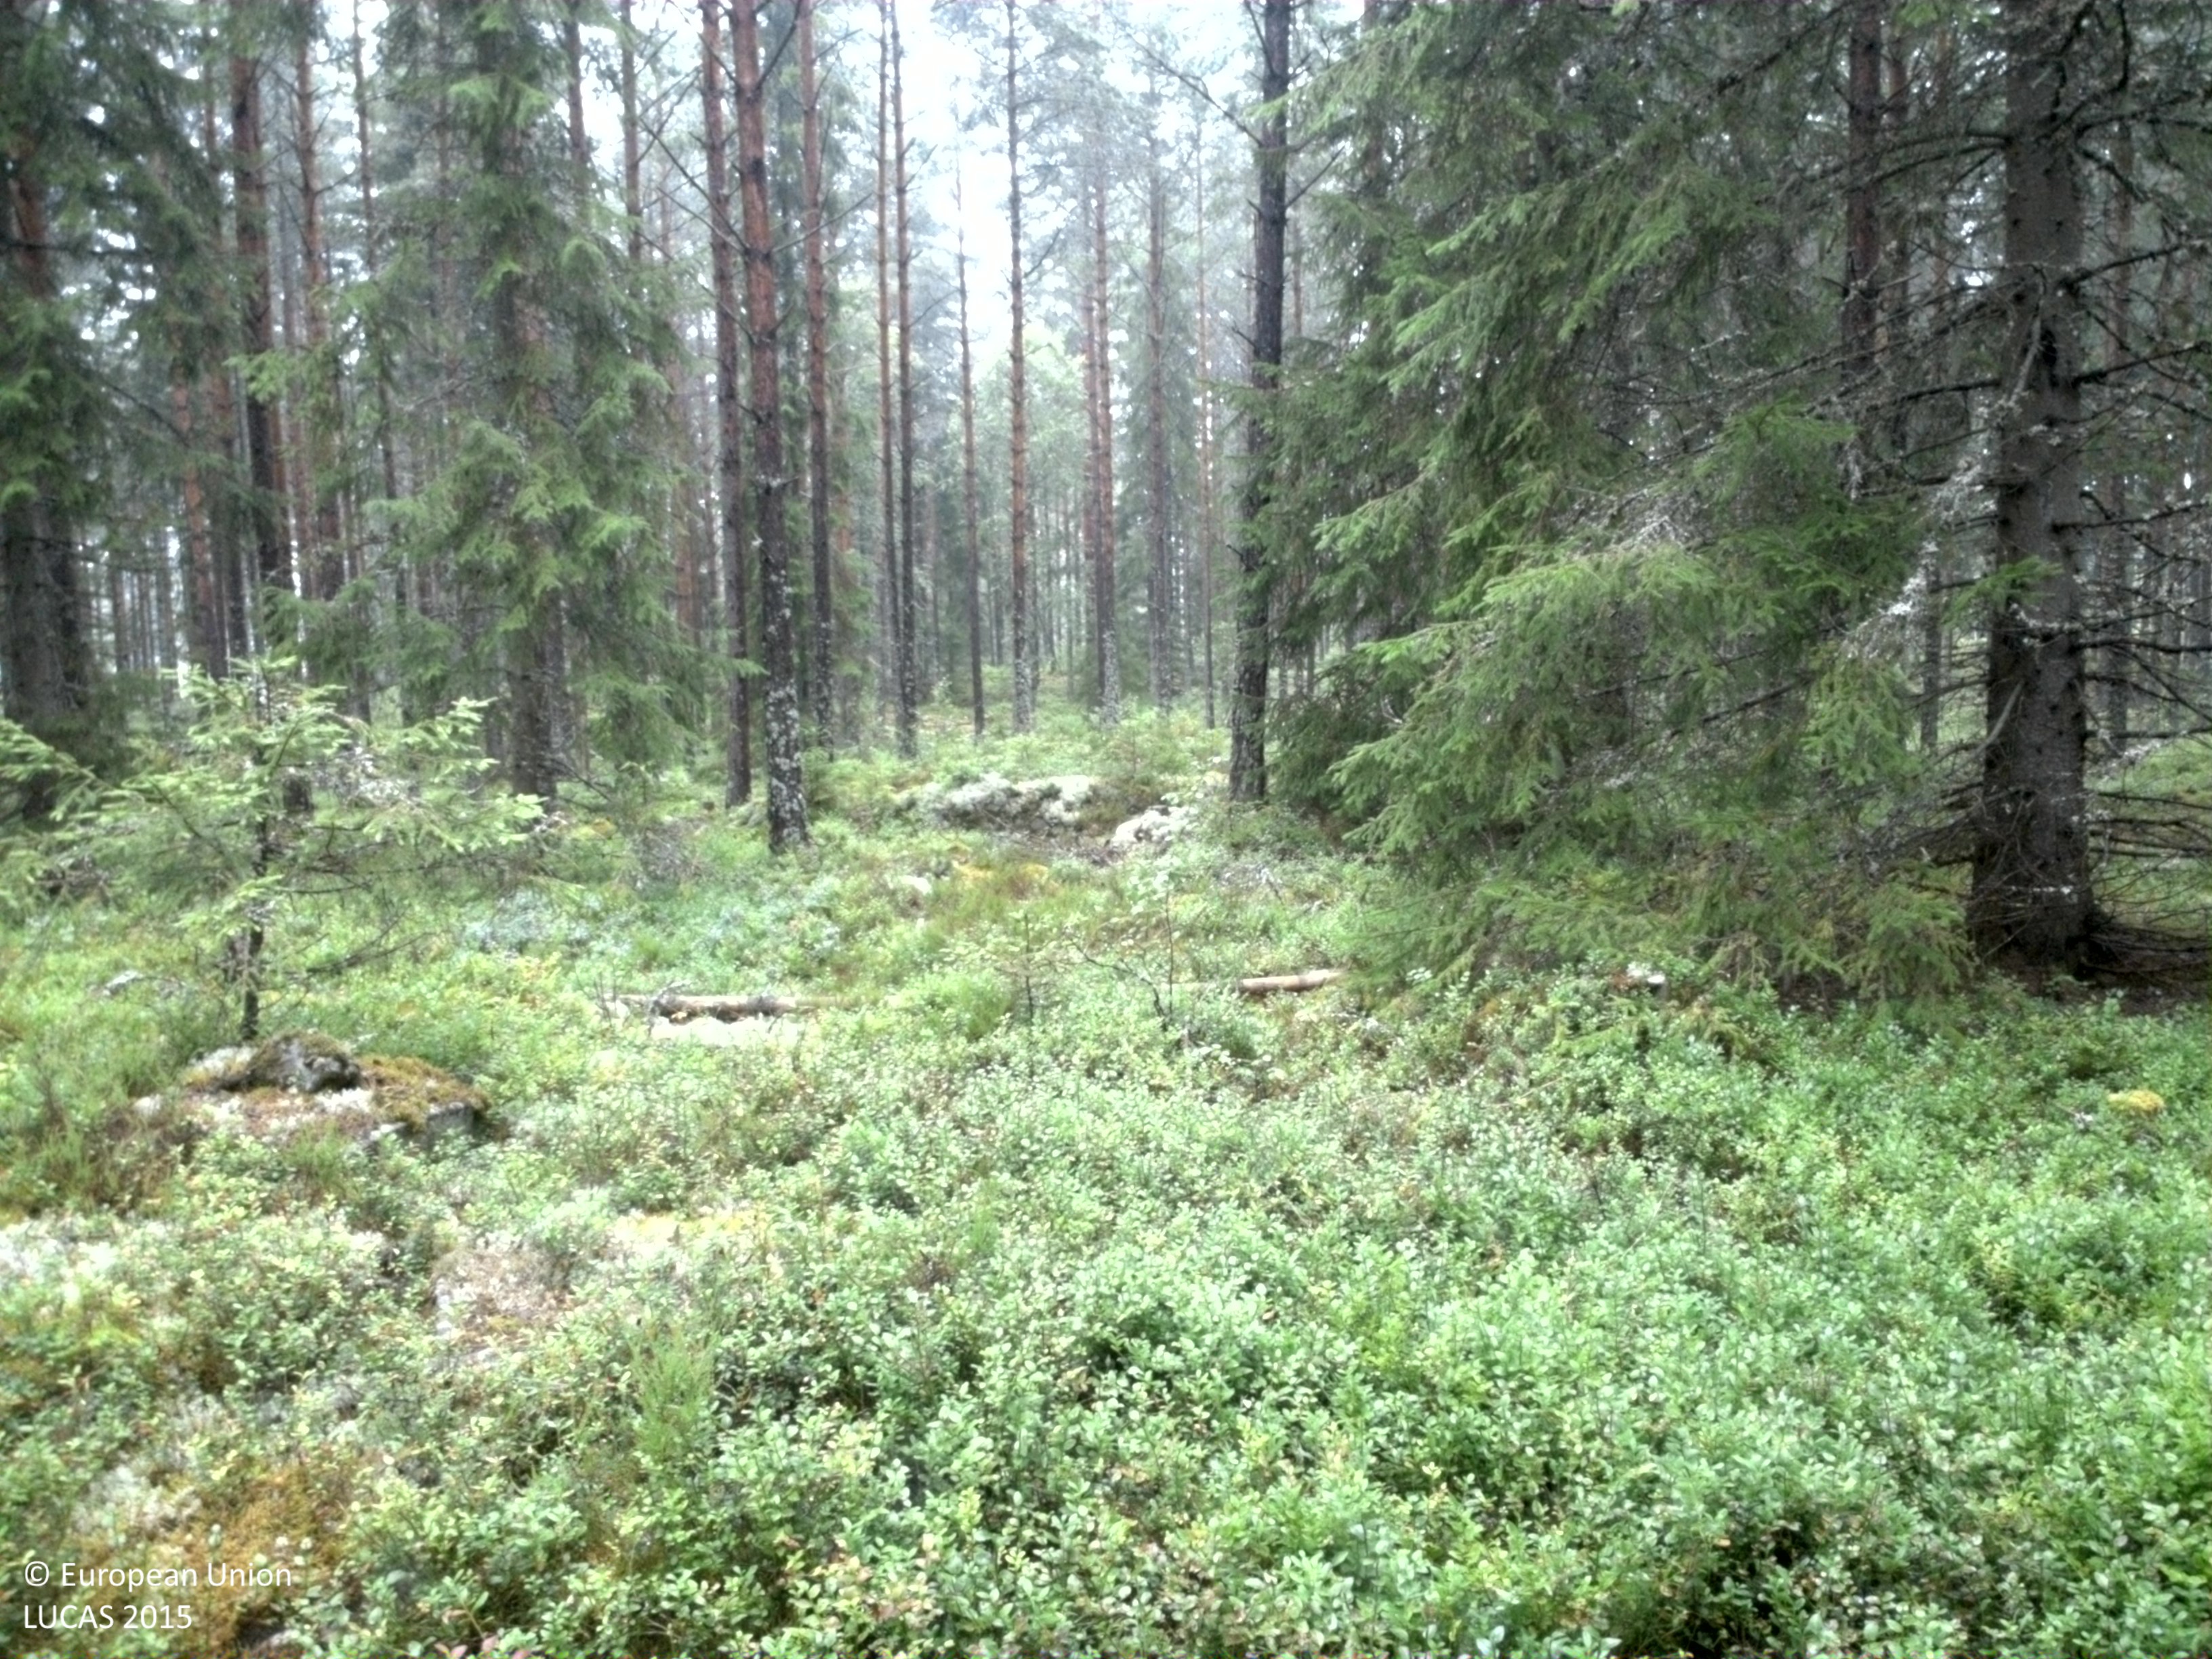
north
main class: Woodland
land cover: Pine dominated coniferous woodland
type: boreal forest
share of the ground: 50 - 75 %
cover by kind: coniferous forest trees 65 %, shrubs 20 %, lichens and mosses 10 %, broadleaved forest trees 5 %
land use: Forestry
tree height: > 5 m
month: August
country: SE
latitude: 59.4430
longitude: 13.1491
